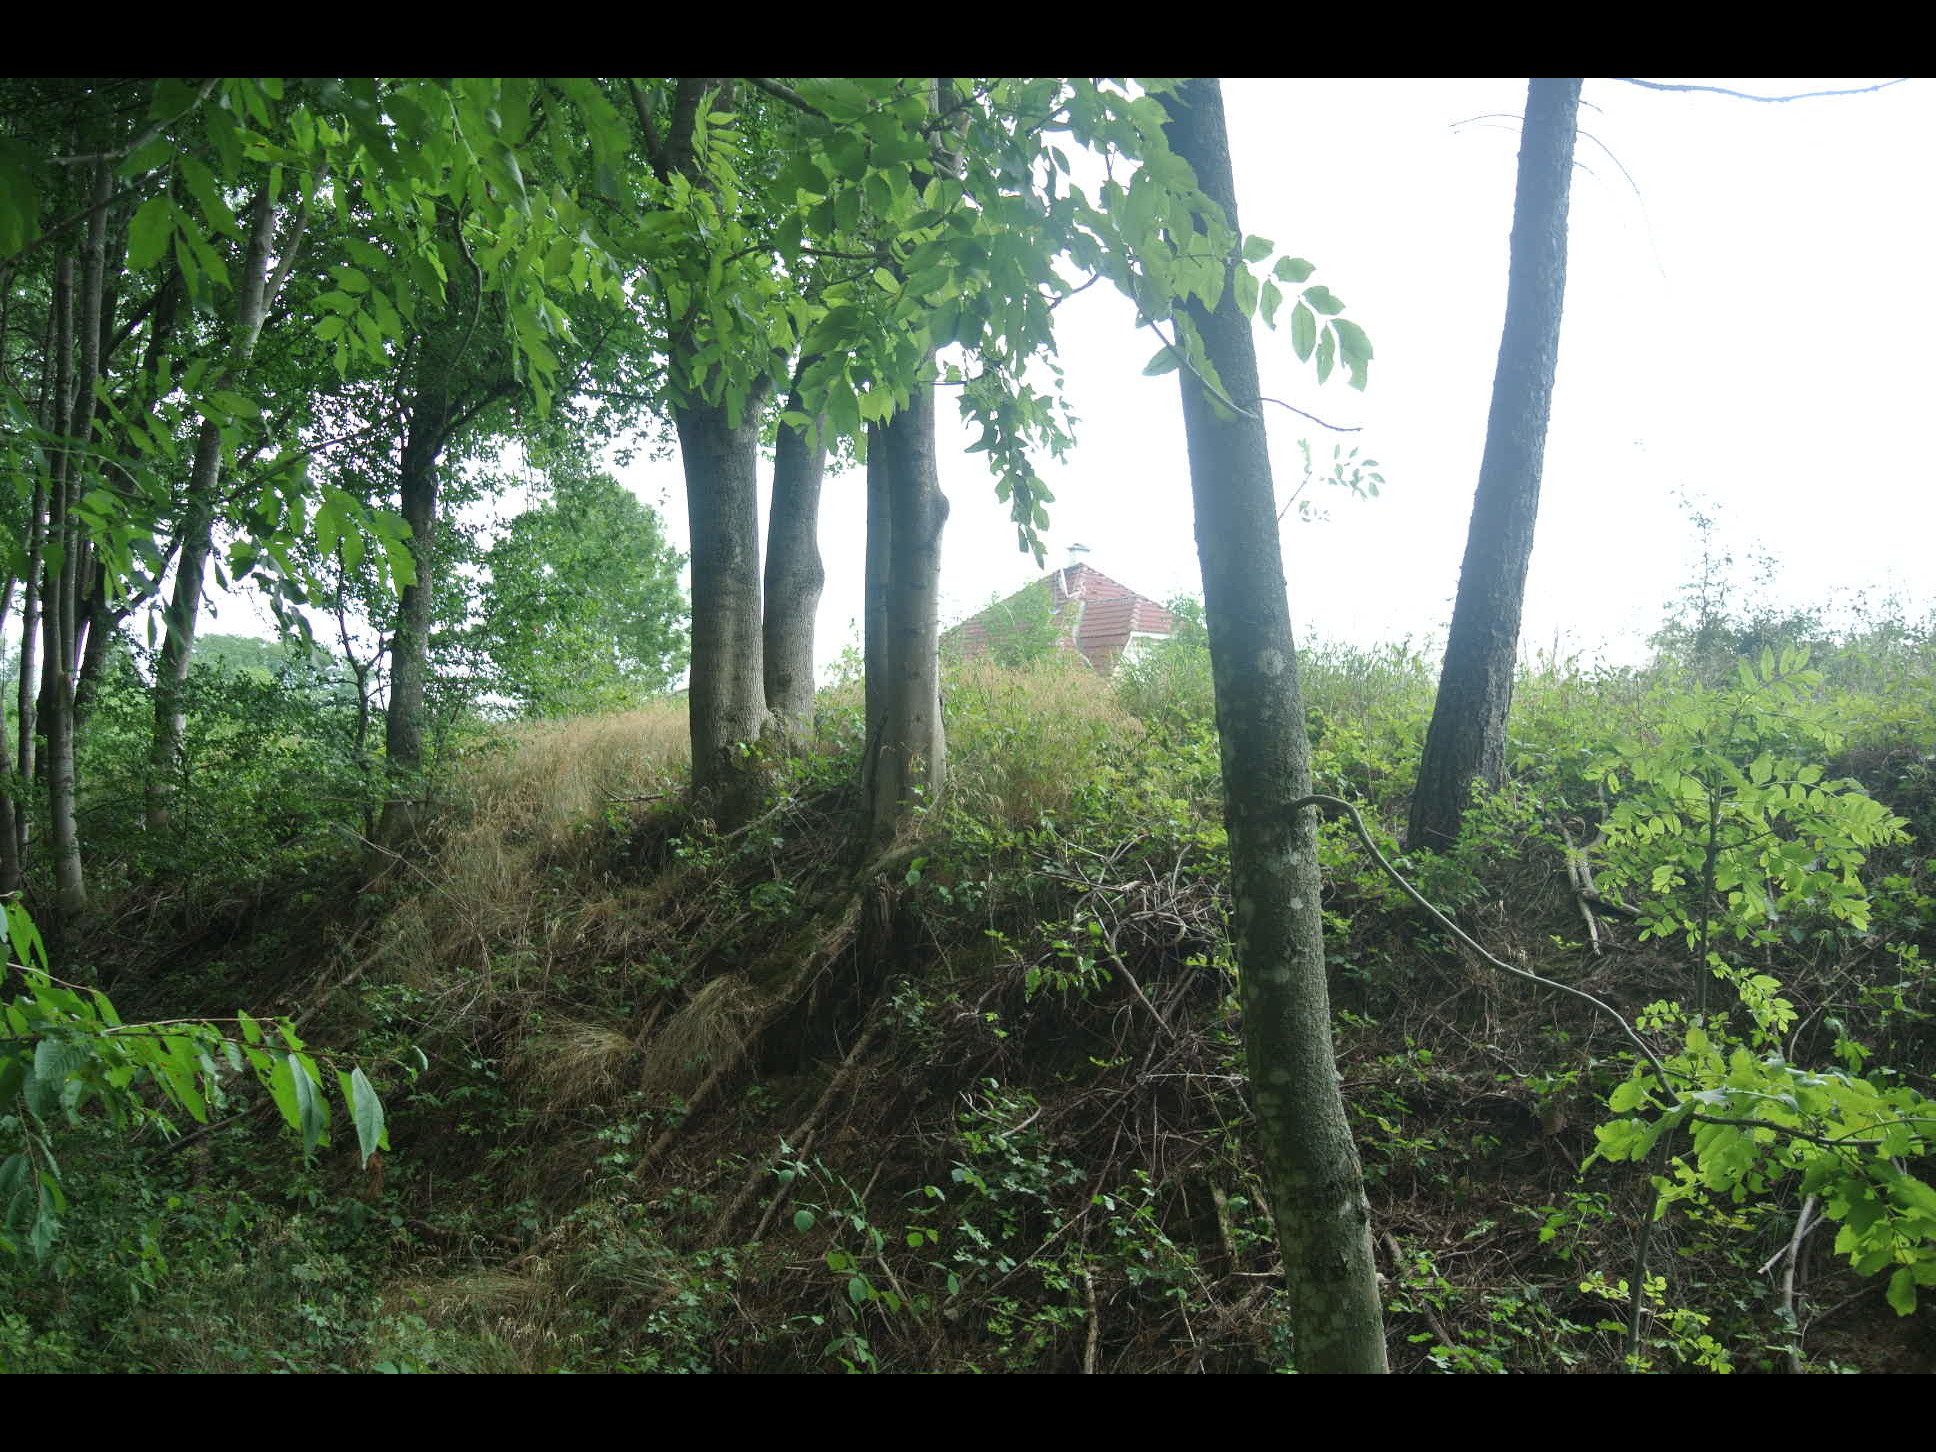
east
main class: Woodland
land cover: Pine dominated mixed woodland
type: alpine coniferous forest
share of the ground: > 75 %
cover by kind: broadleaved forest trees 65 %, coniferous forest trees 35 %
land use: Forestry
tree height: > 5 m
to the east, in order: Pine dominated mixed woodland; Shrubland with sparse tree cover; Artificial constructions in urban areas; Soya; Common wheat; Grass margins; Artificial constructions in urban areas; Broadleaved woodland; Rivers and streams; Broadleaved woodland; Artificial constructions in urban areas
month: July
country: AT
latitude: 47.5325
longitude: 16.3928
